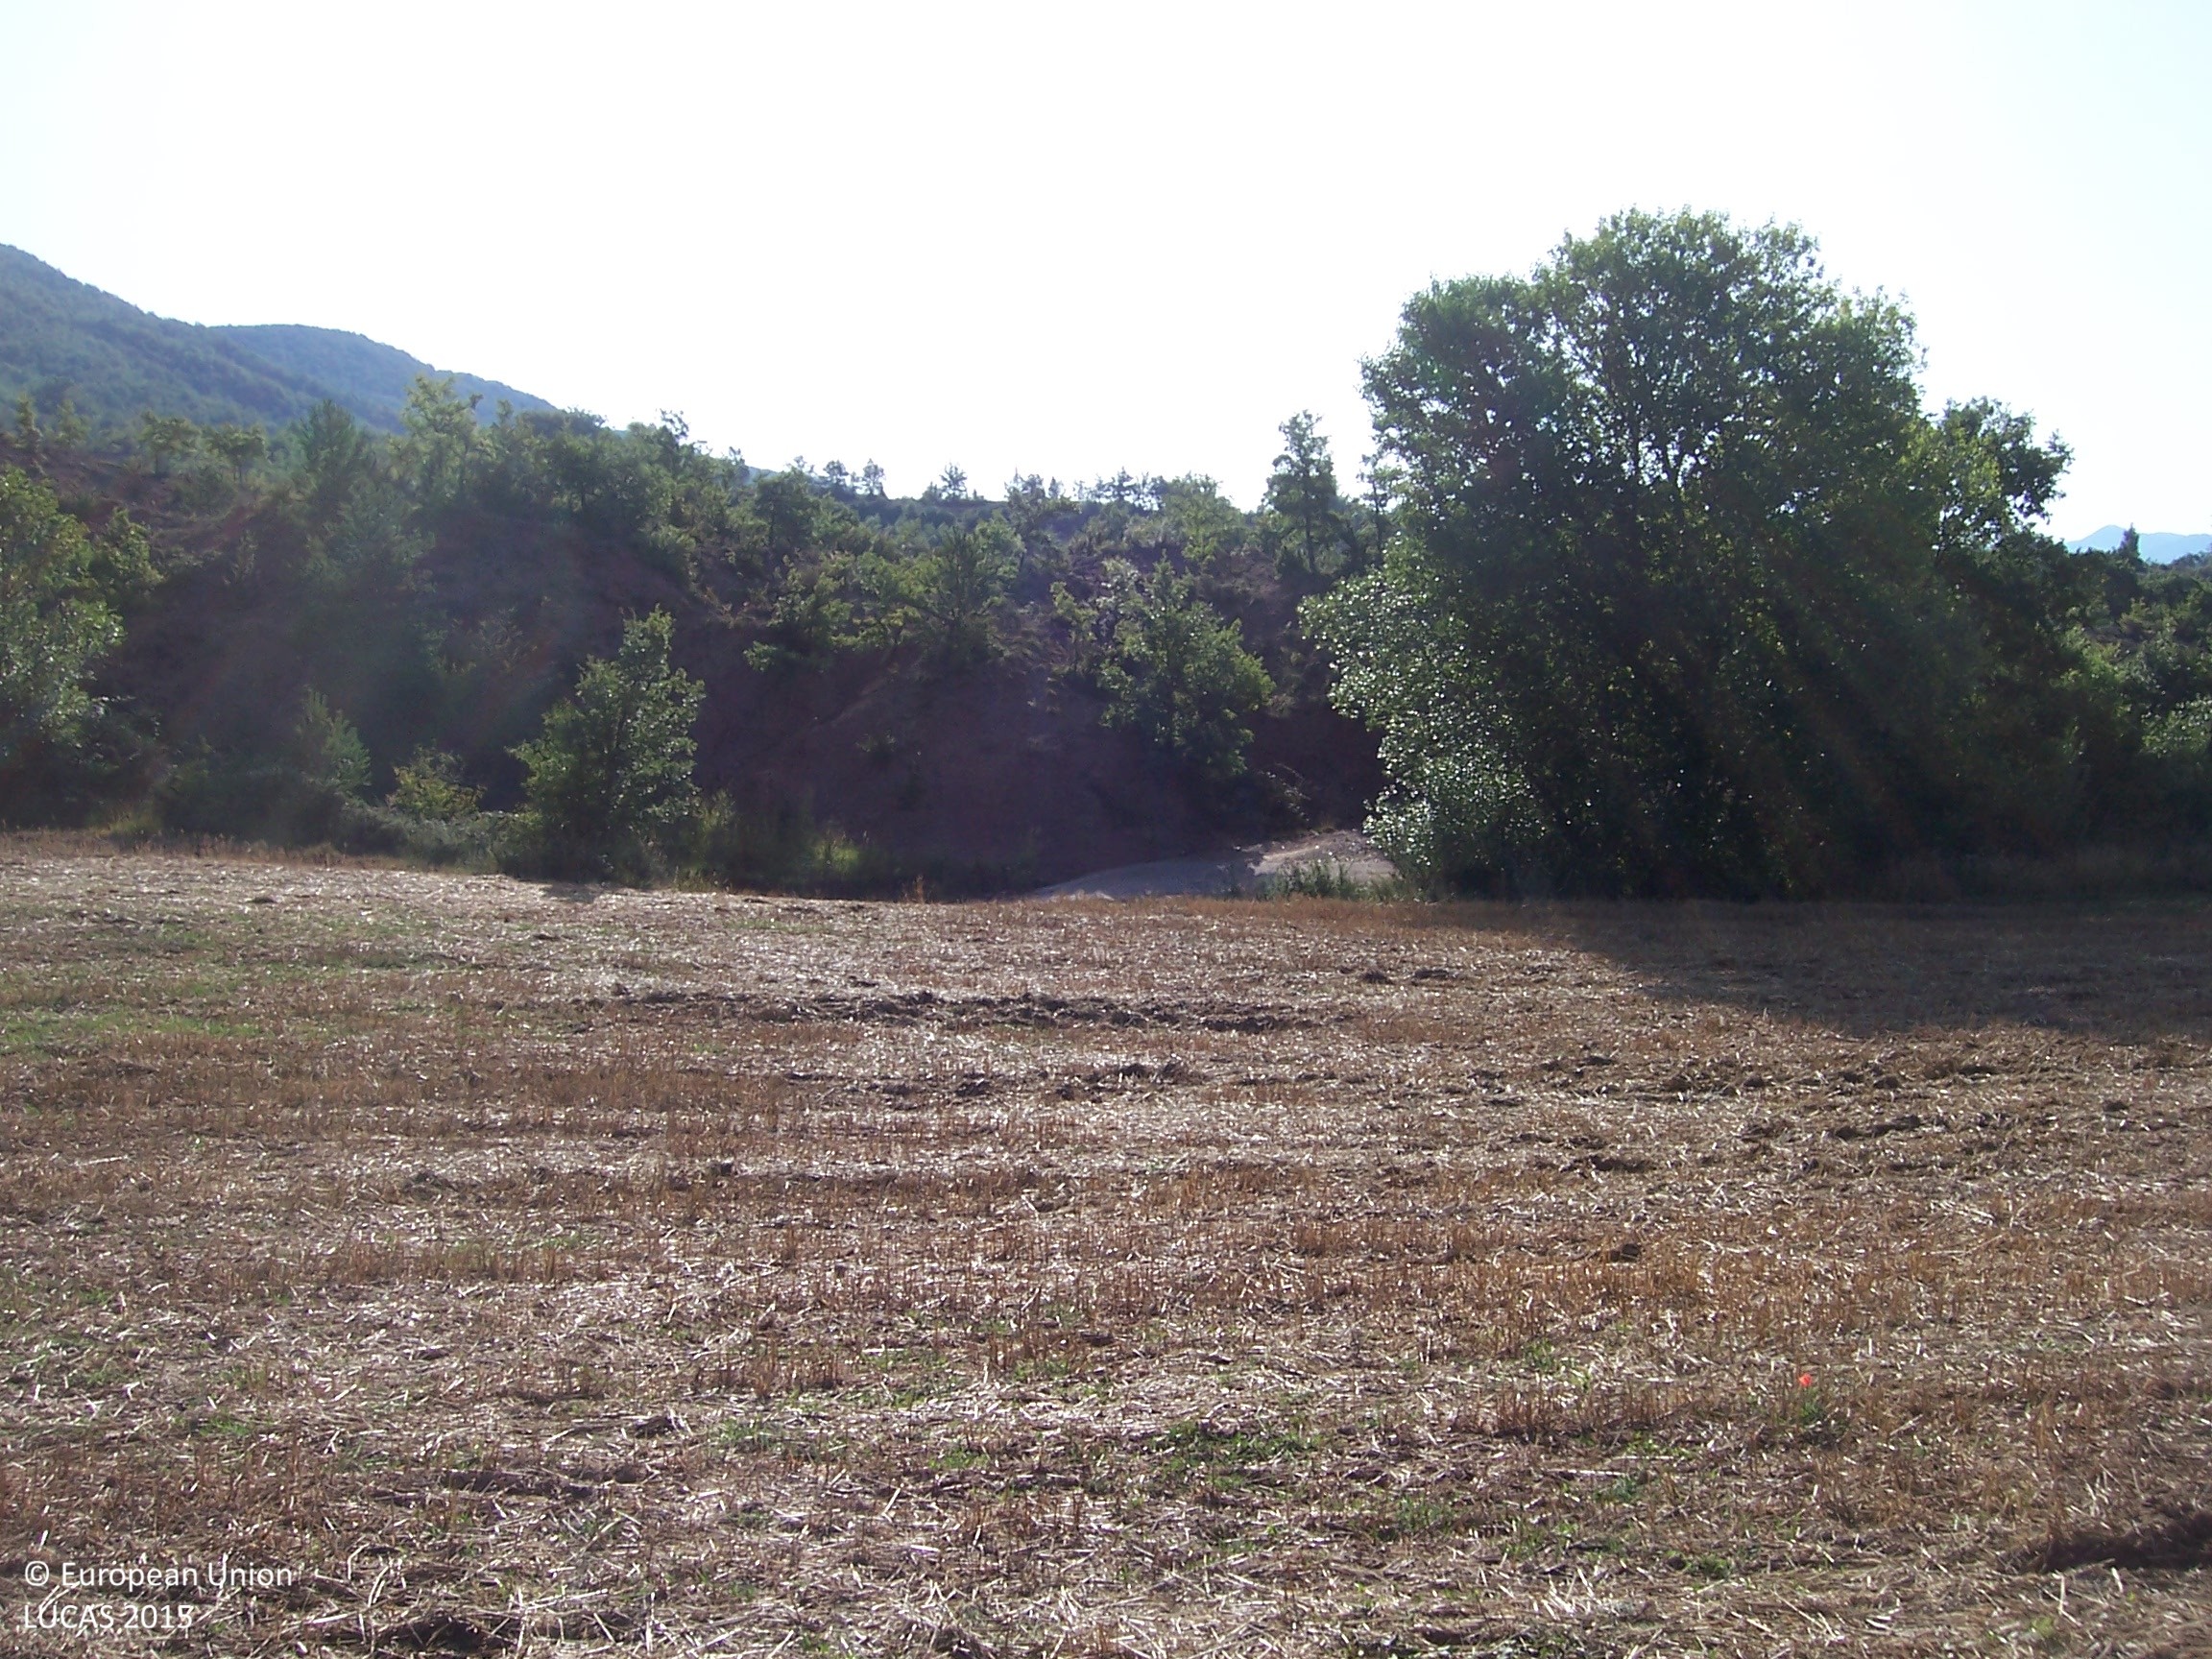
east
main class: Cropland
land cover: Common wheat
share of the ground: < 10 %
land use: Agriculture (excluding fallow land and kitchen gardens)
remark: Harvested field
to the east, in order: Common wheat; Tracks; Shrubland with sparse tree cover; Dry stone walls; Shrubland with sparse tree cover; Common wheat; Broadleaved woodland; Rivers and streams; Broadleaved woodland; Grassland without tree/shrub cover
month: August
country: ES
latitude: 42.5116
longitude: -0.4563
